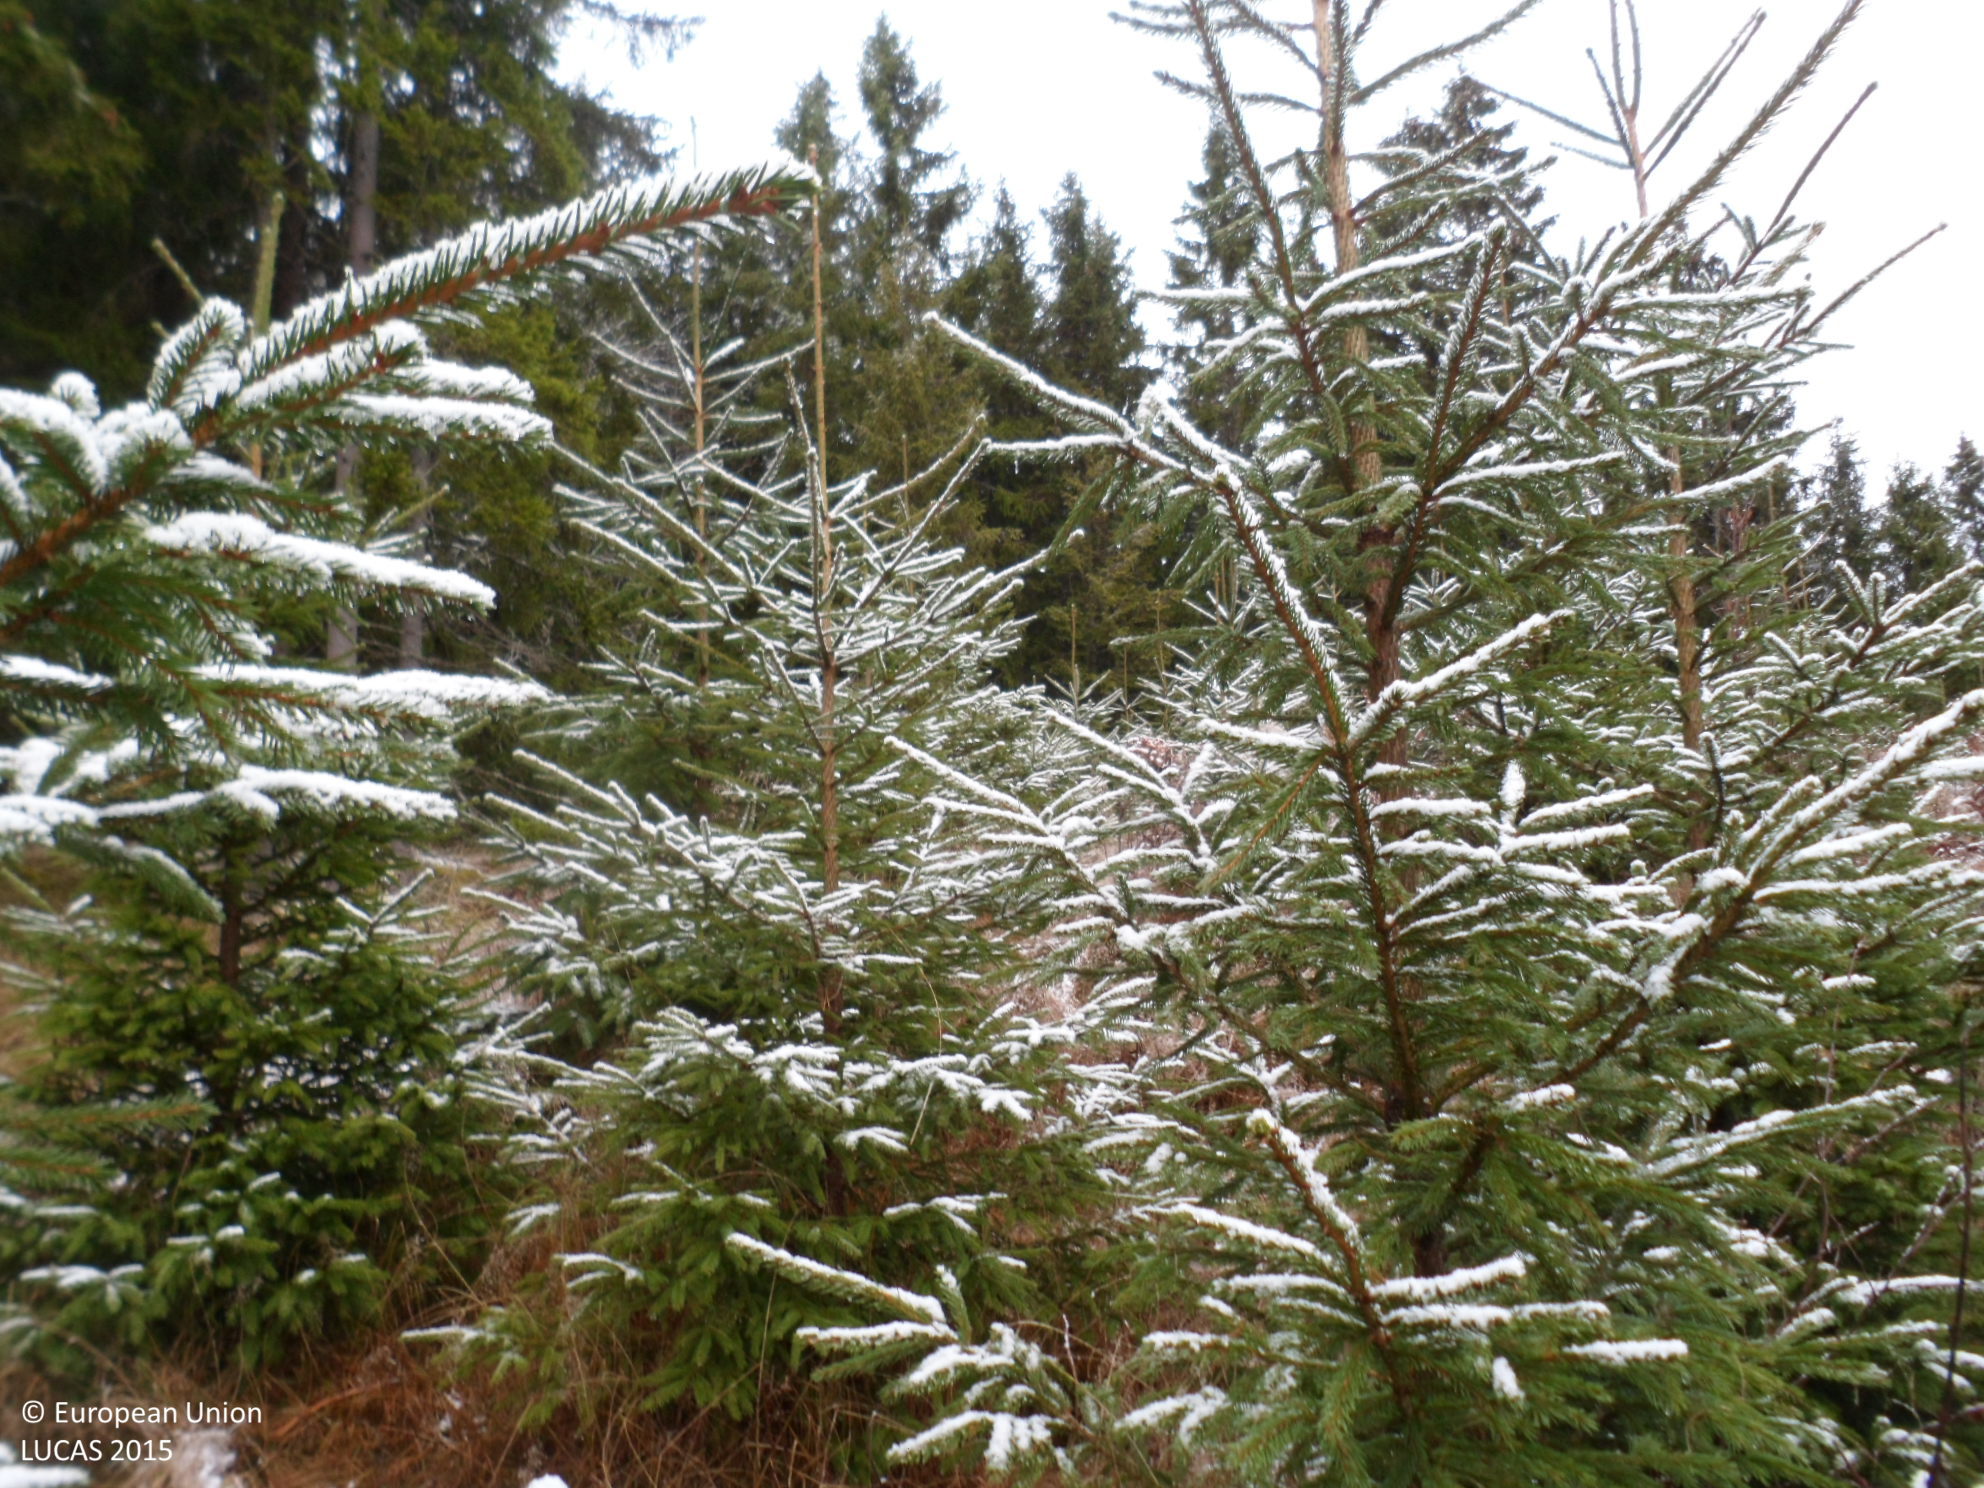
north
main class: Woodland
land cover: Spruce dominated coniferous woodland
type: boreal forest
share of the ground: 50 - 75 %
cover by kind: coniferous forest trees 45 %, herbaceous plants 30 %, broadleaved forest trees 10 %, shrubs 10 %, lichens and mosses 5 %
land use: Forestry
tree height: < 5 m
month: November
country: SE
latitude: 57.5575
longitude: 14.7925
